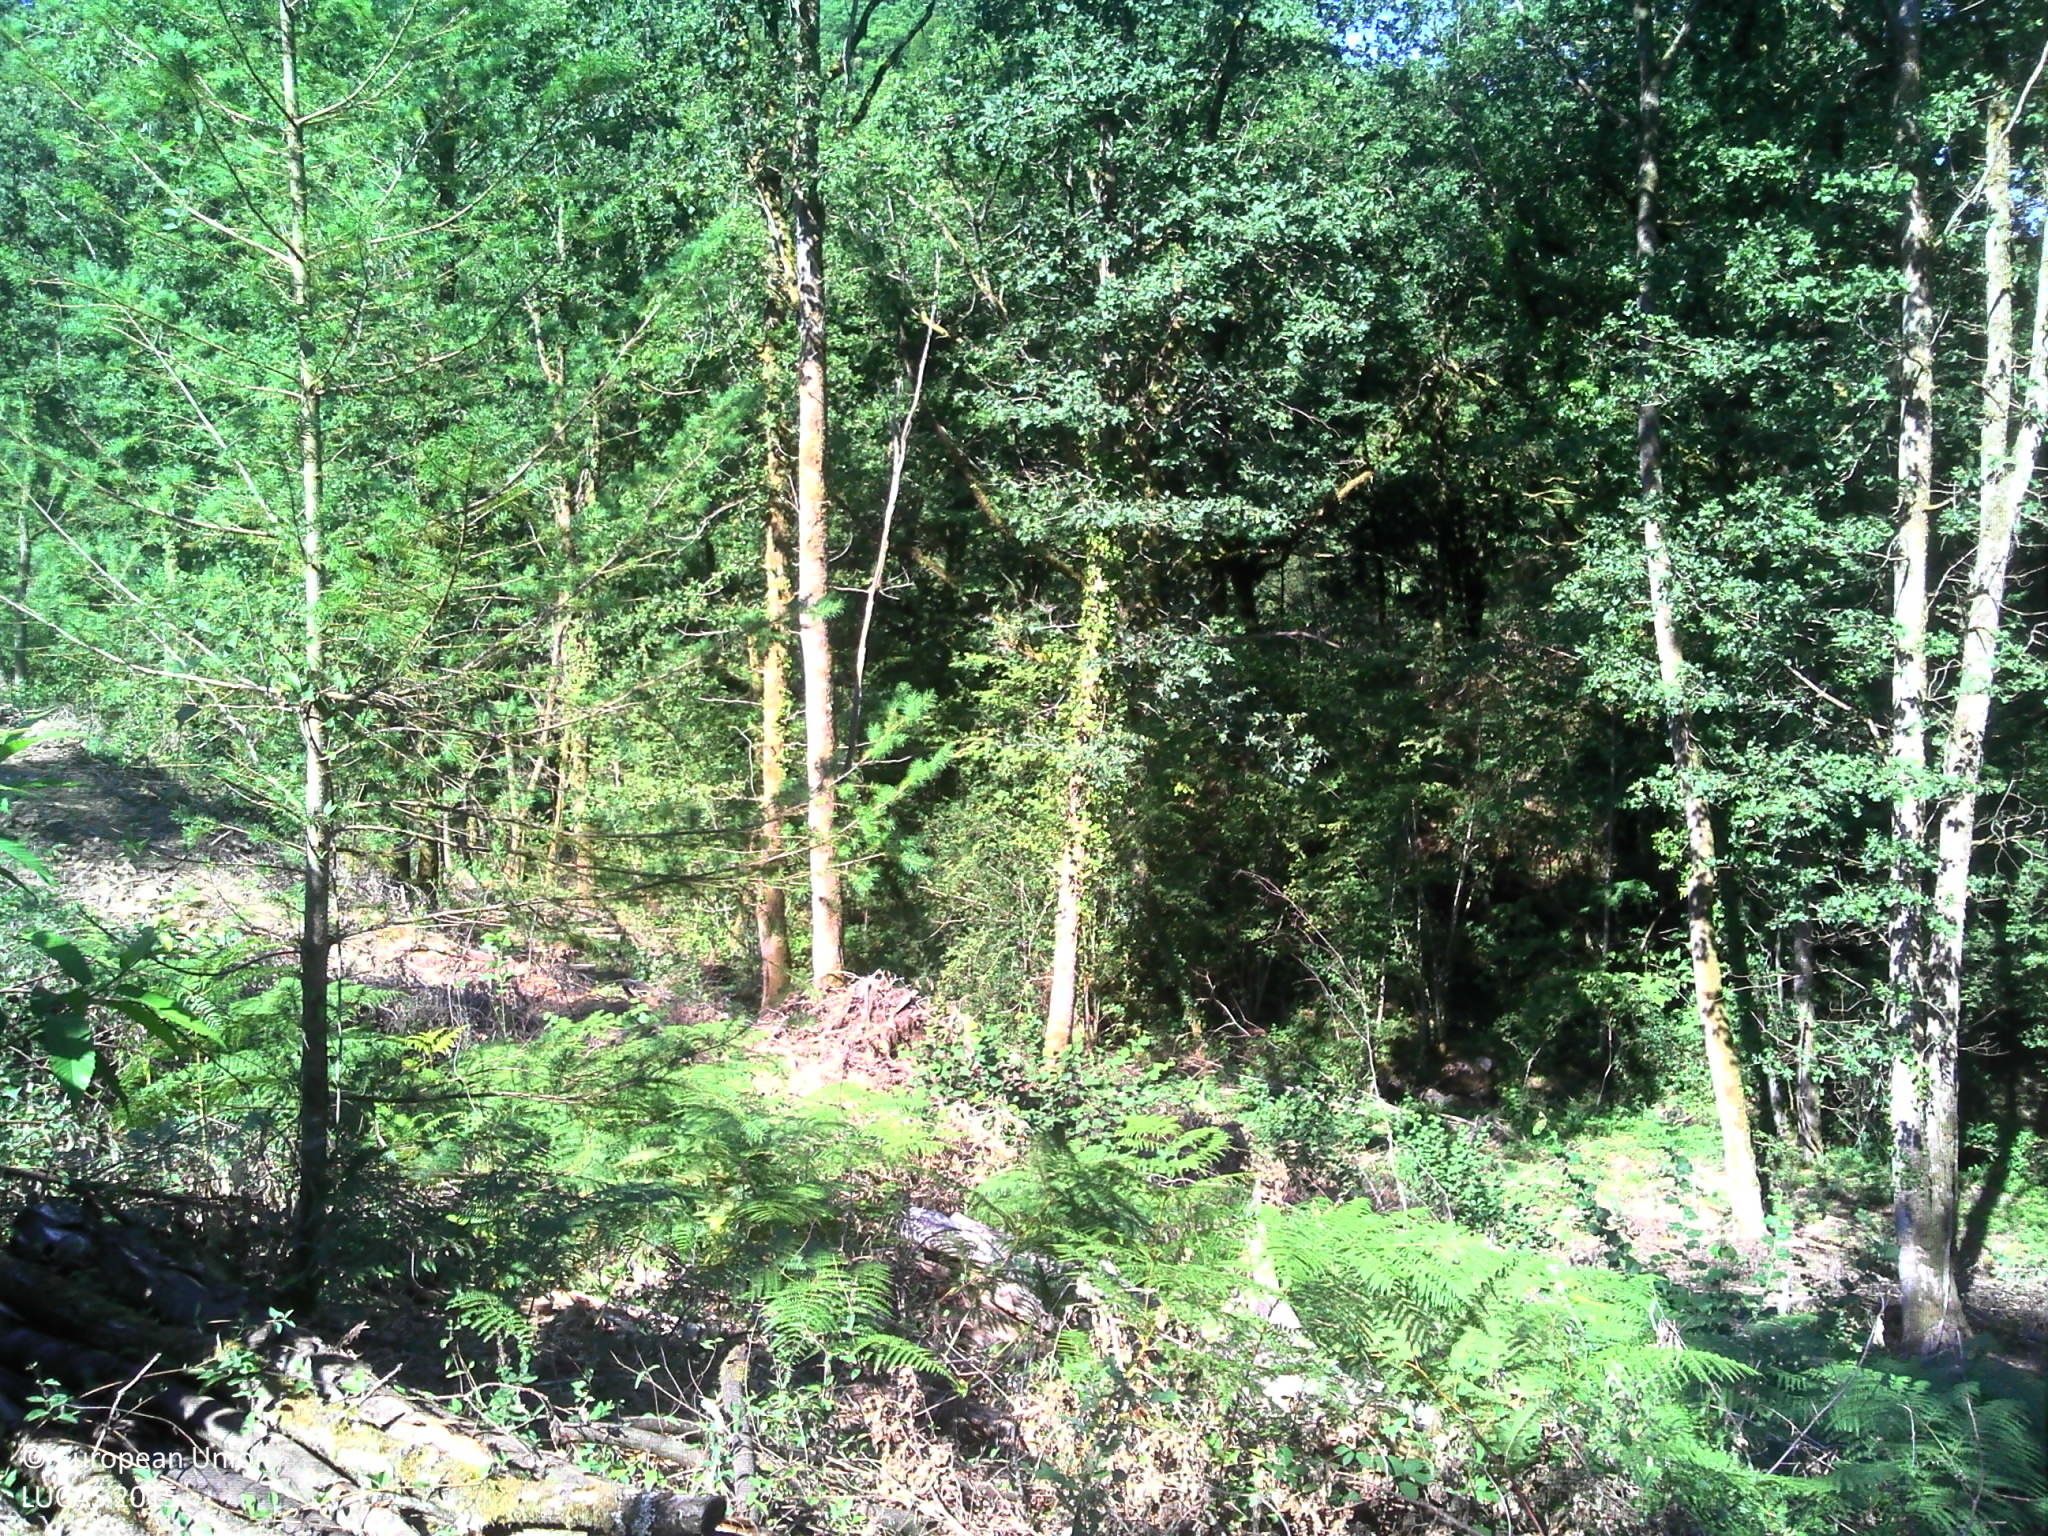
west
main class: Grassland
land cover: Spontaneously vegetated surfaces
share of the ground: > 75 %
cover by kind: herbaceous plants 95 %, shrubs 5 %
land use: Forestry
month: August
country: FR
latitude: 45.8795
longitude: 1.4234
